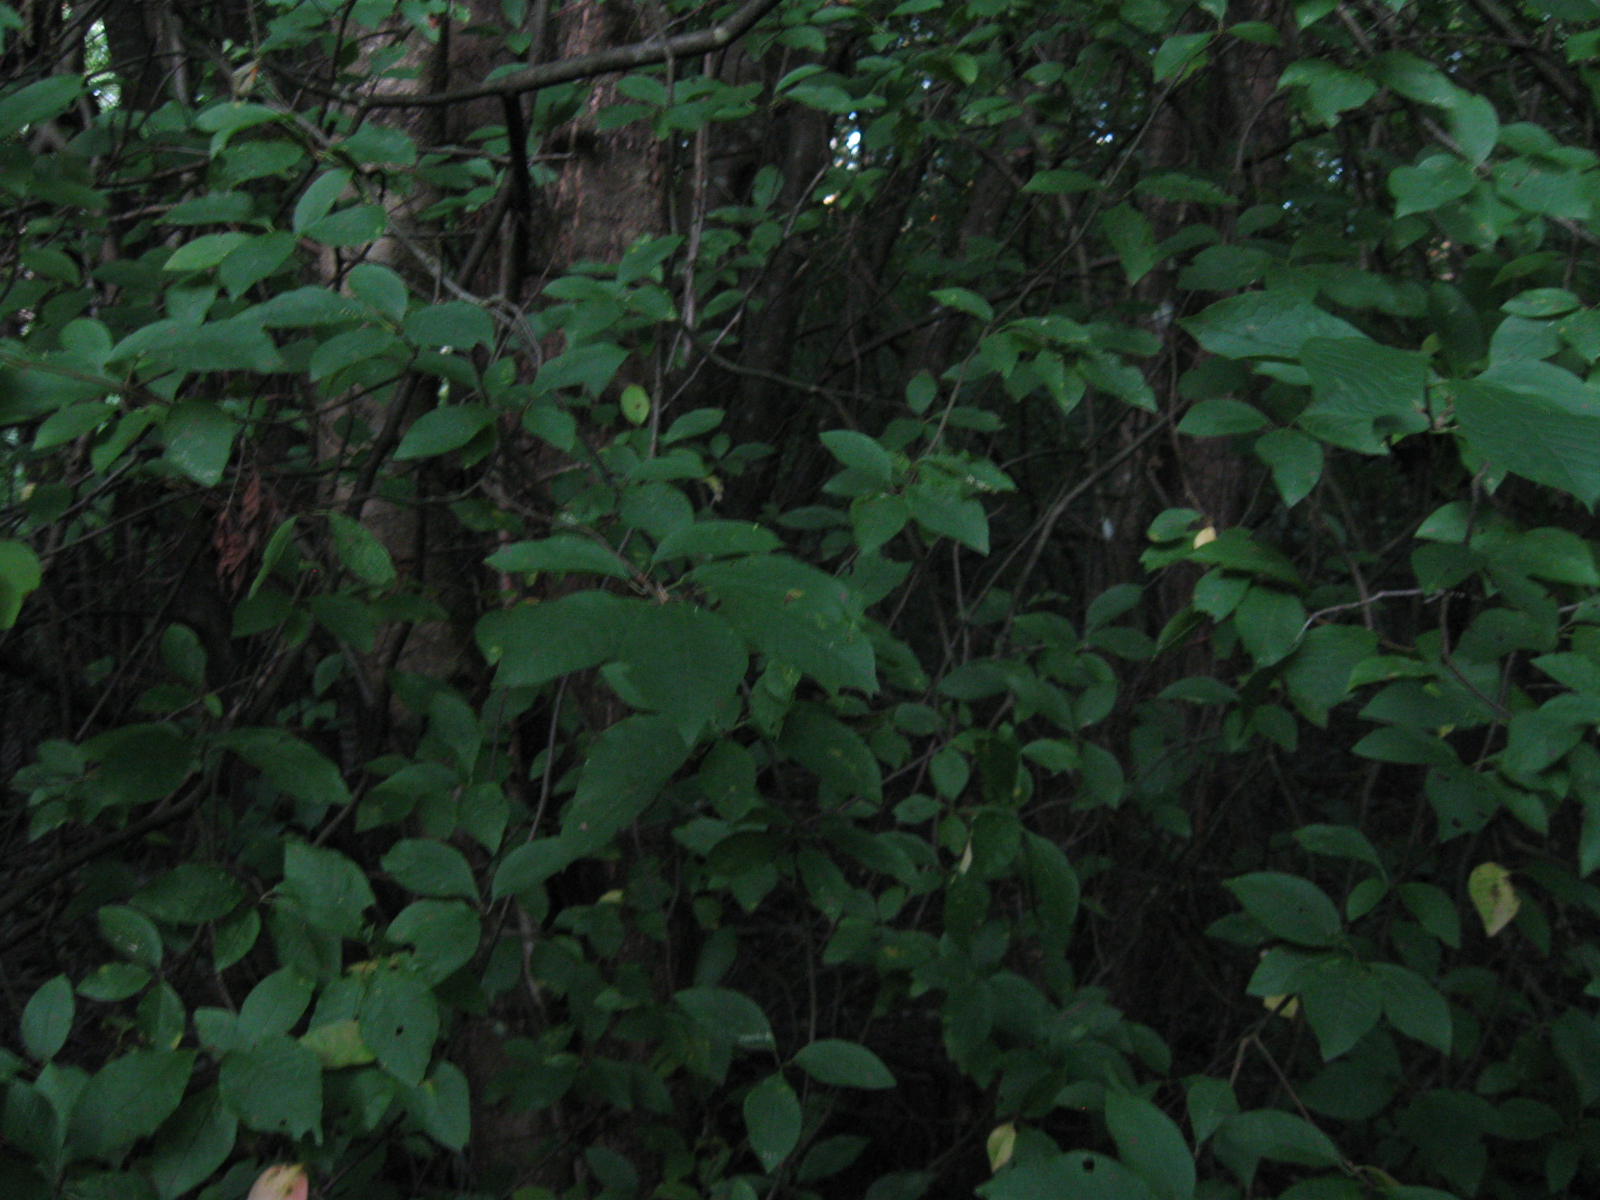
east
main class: Woodland
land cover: Broadleaved woodland
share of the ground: > 75 %
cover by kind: broadleaved forest trees 90 %, shrubs 5 %, herbaceous plants 5 %
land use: Forestry
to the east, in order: Broadleaved woodland; Pine dominated mixed woodland; Spontaneously vegetated surfaces; Pine dominated mixed woodland; Tracks; Spruce dominated coniferous woodland
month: July
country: LT
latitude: 54.3847
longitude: 24.3744
